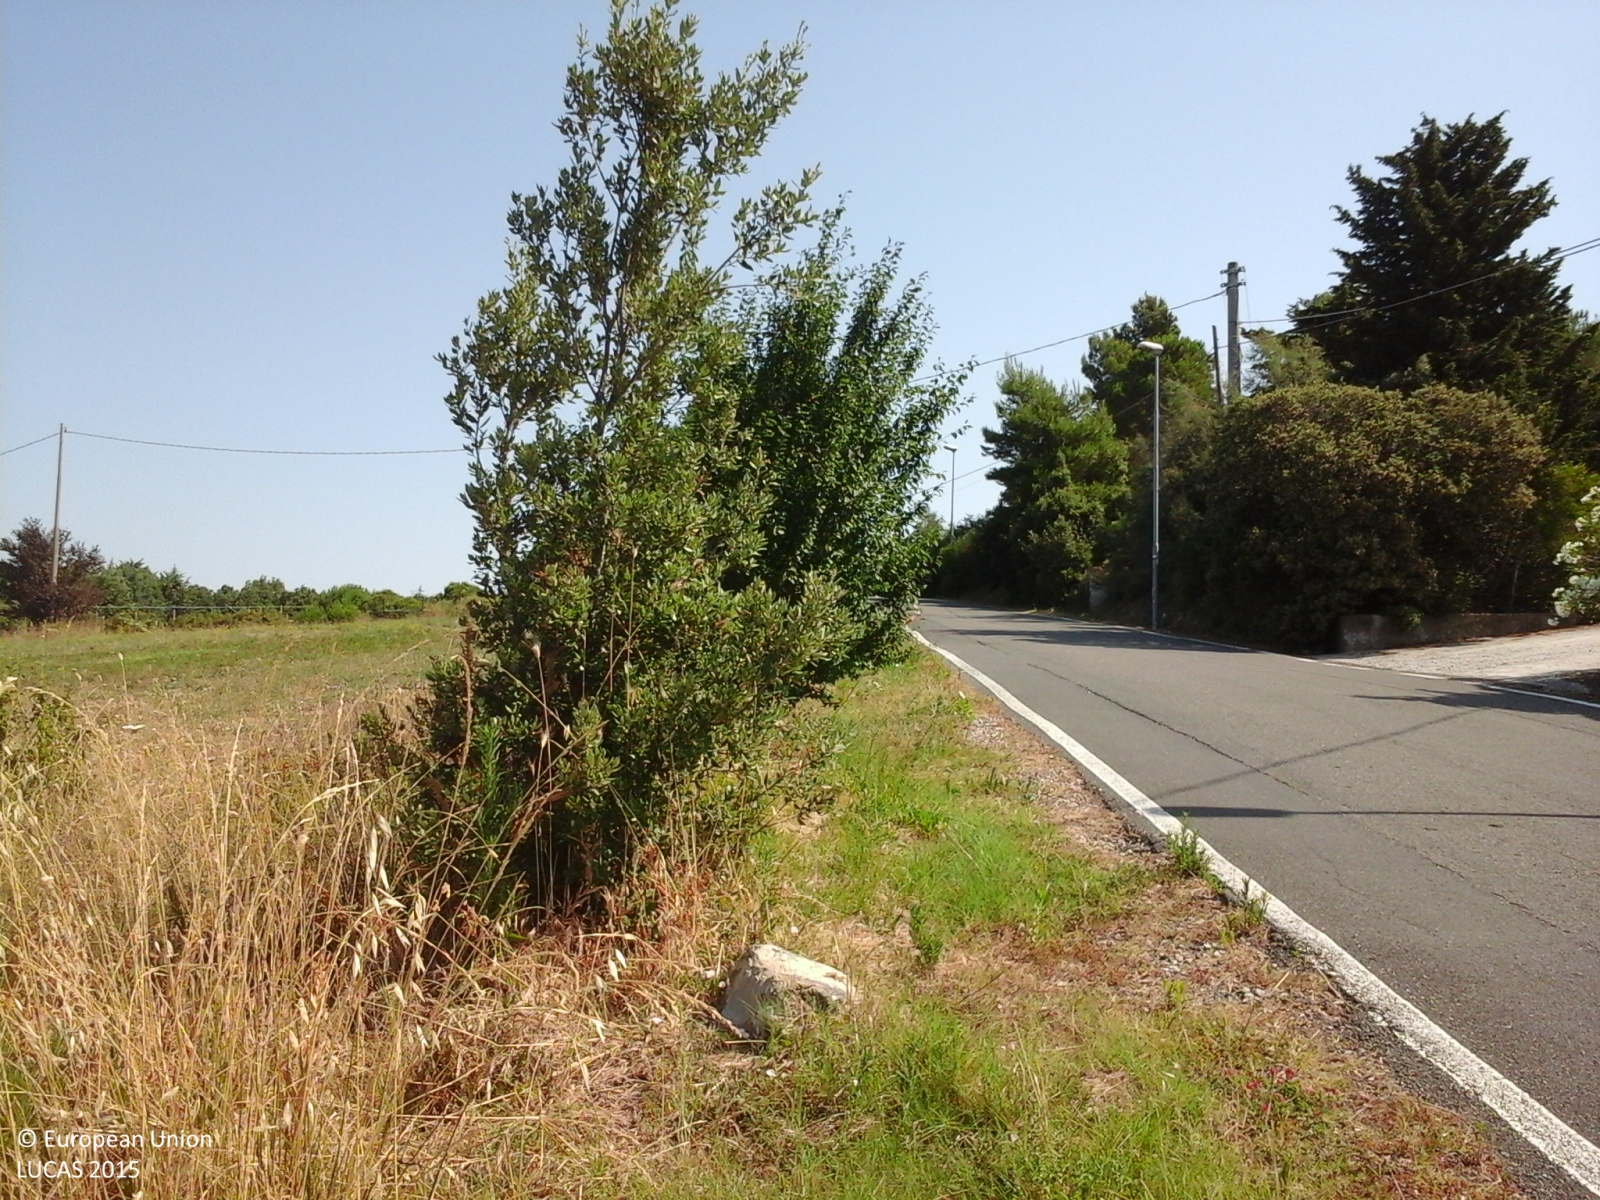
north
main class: Cropland
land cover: Temporary grasslands
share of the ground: > 75 %
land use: Agriculture (excluding fallow land and kitchen gardens)
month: August
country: IT
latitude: 43.3745
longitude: 10.6030
